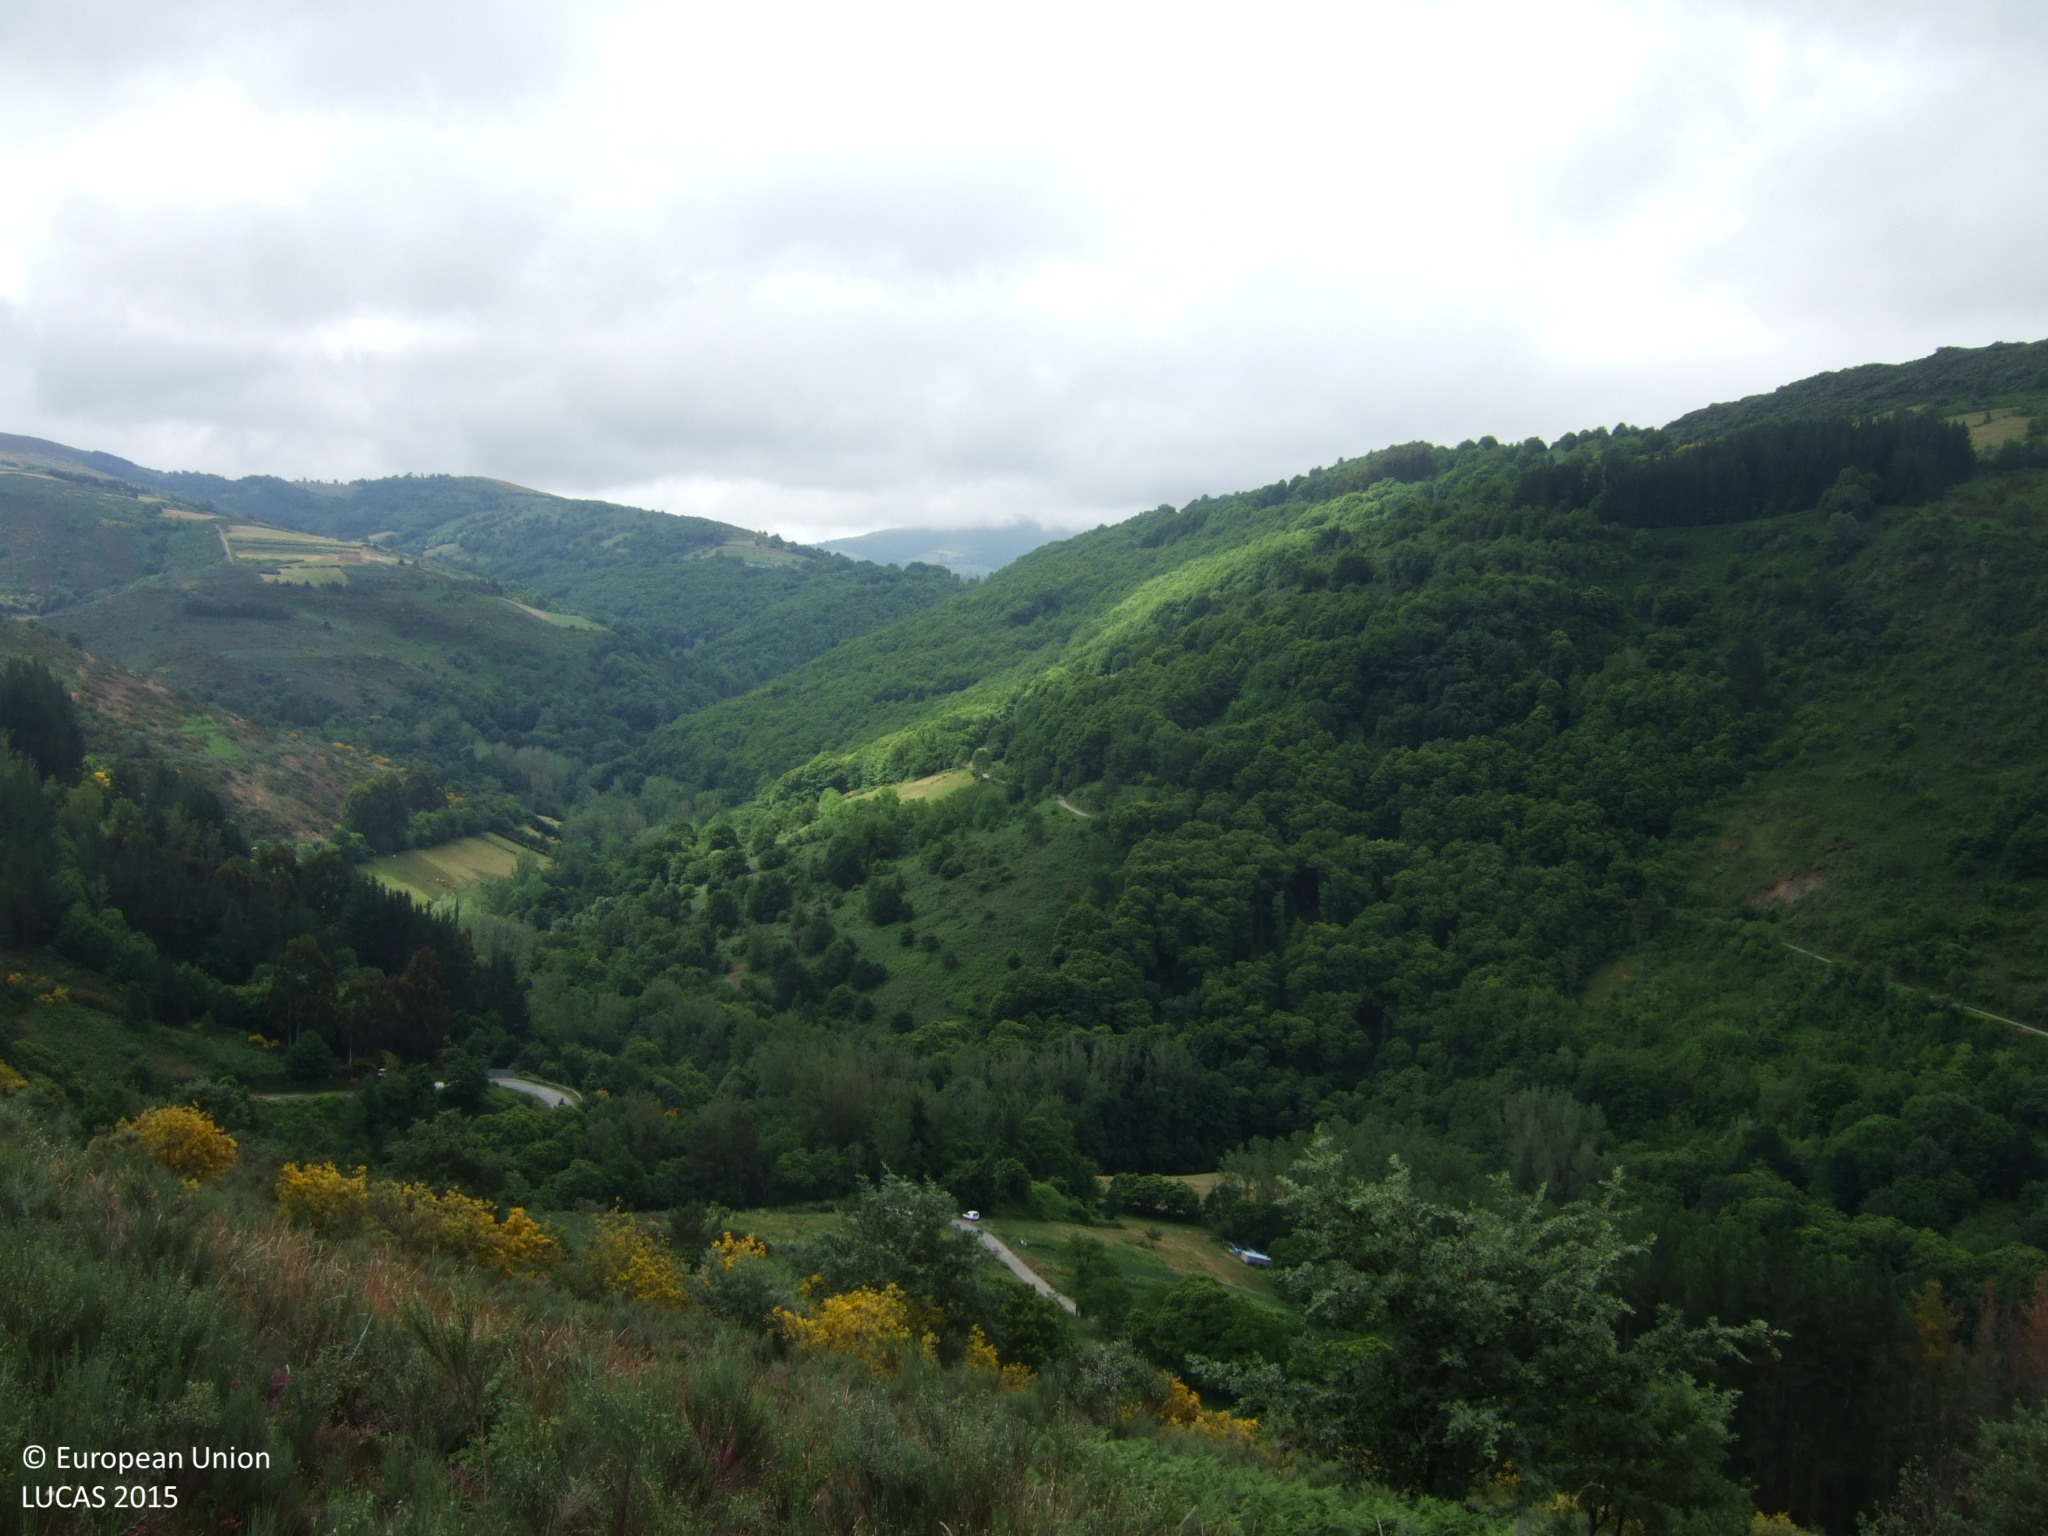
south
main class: Shrubland
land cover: Shrubland without tree cover
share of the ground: > 75 %
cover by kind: shrubs 85 %, herbaceous plants 10 %, unconsolidated bare surface 5 %
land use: Semi-natural and natural areas not in use
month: June
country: ES
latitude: 42.8083
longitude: -7.0970
